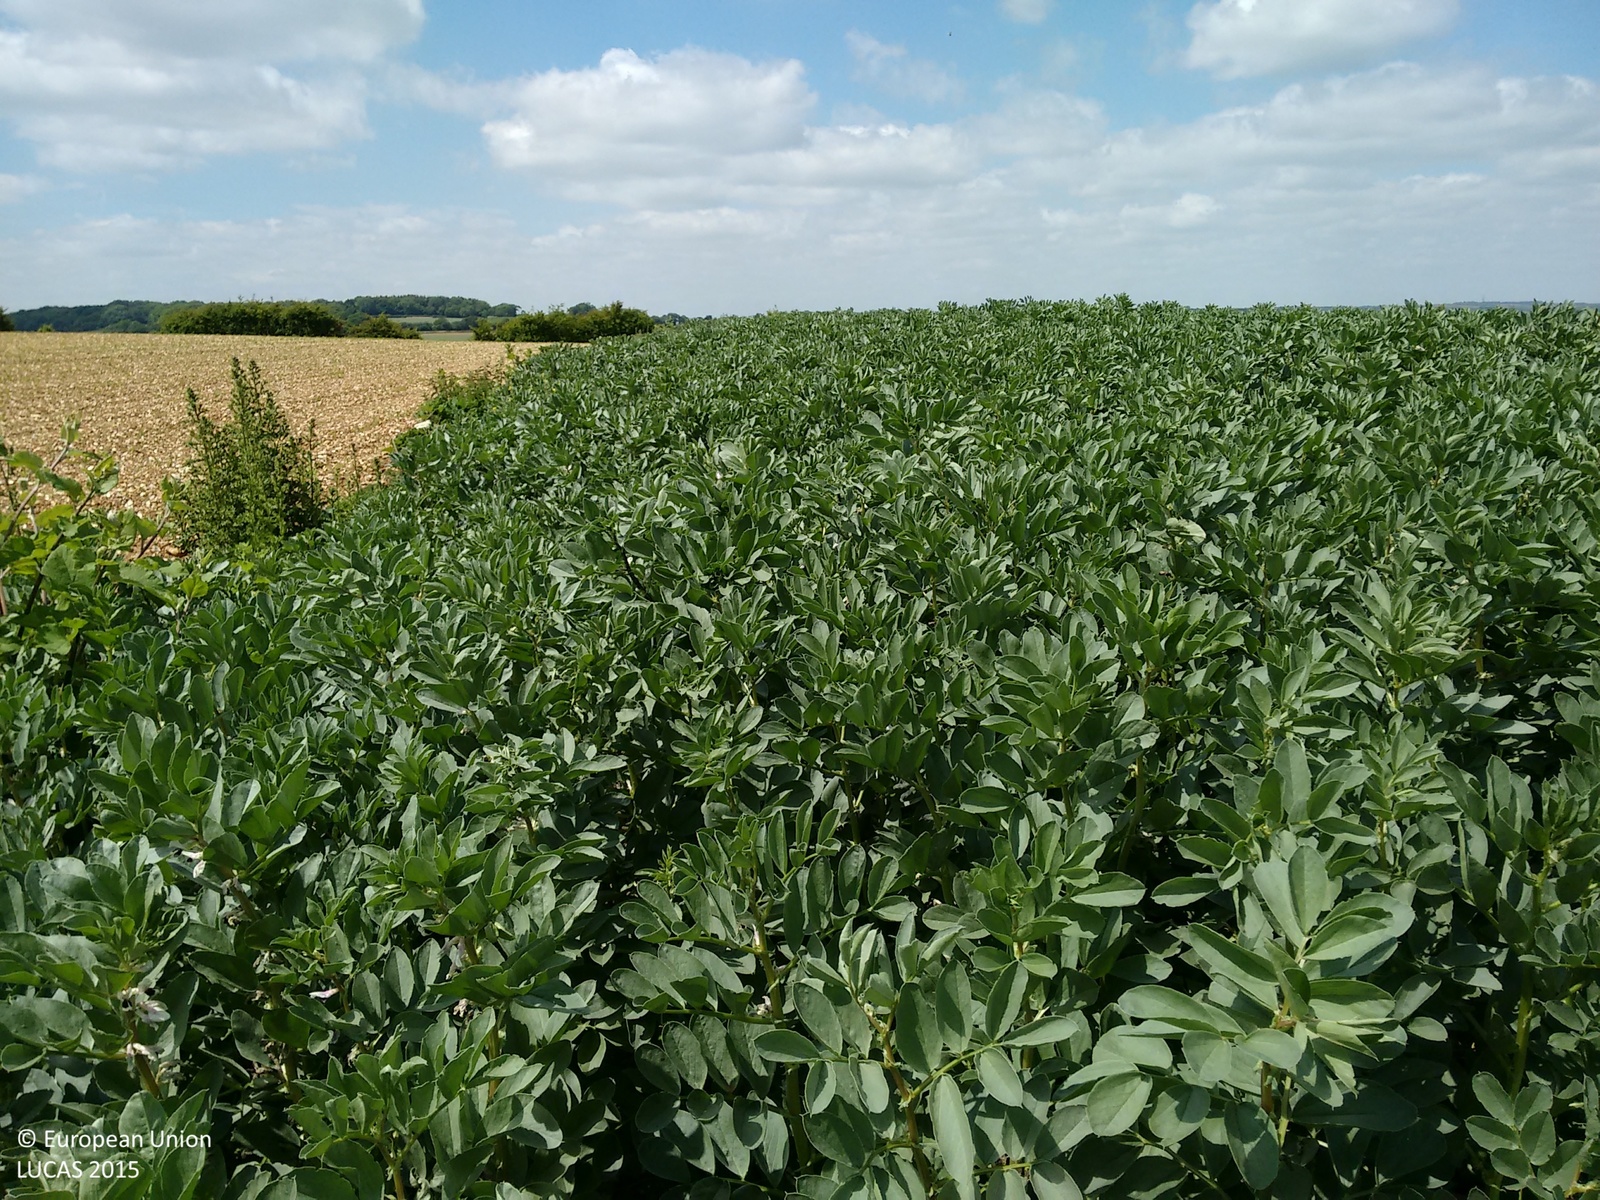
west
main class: Cropland
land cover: Dry pulses
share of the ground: > 75 %
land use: Agriculture (excluding fallow land and kitchen gardens)
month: June
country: GB
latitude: 51.4744
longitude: -1.4679
